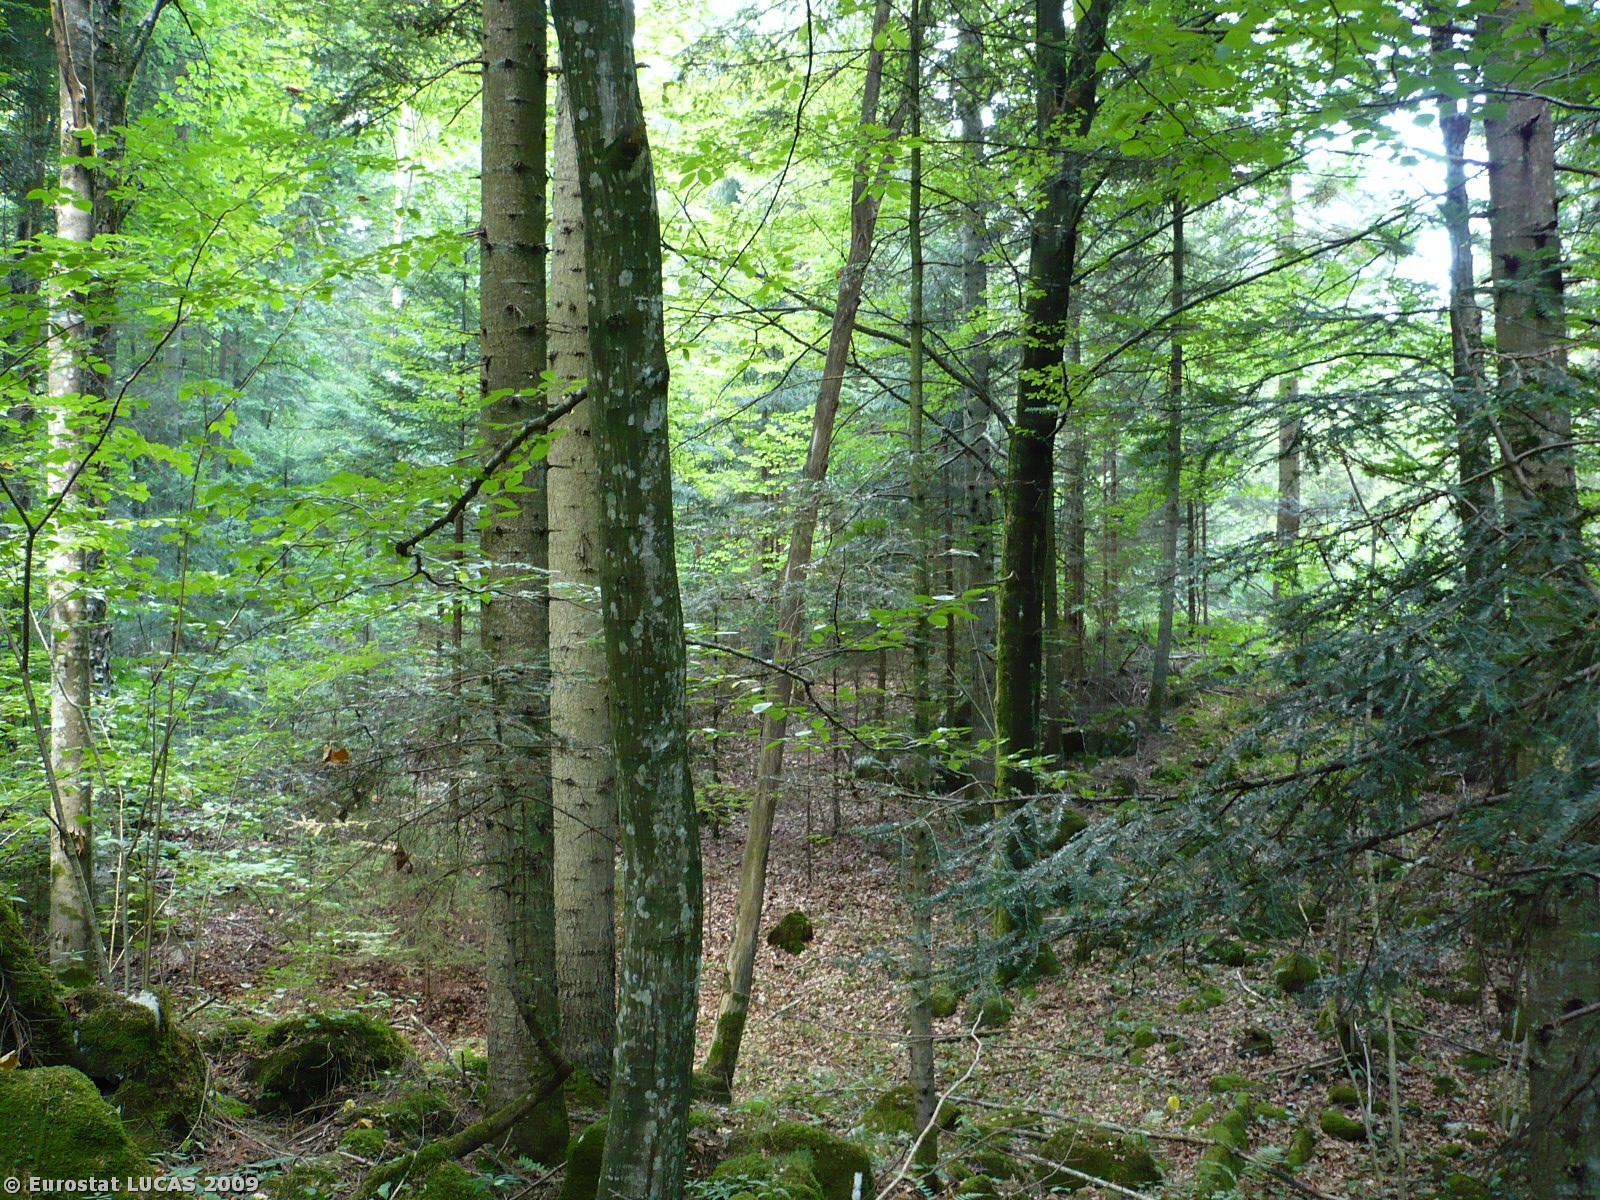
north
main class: Woodland
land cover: Mixed woodland
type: beech forest
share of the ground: > 75 %
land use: Forestry
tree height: > 5 m
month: August
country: SI
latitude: 45.8484
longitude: 14.3357
